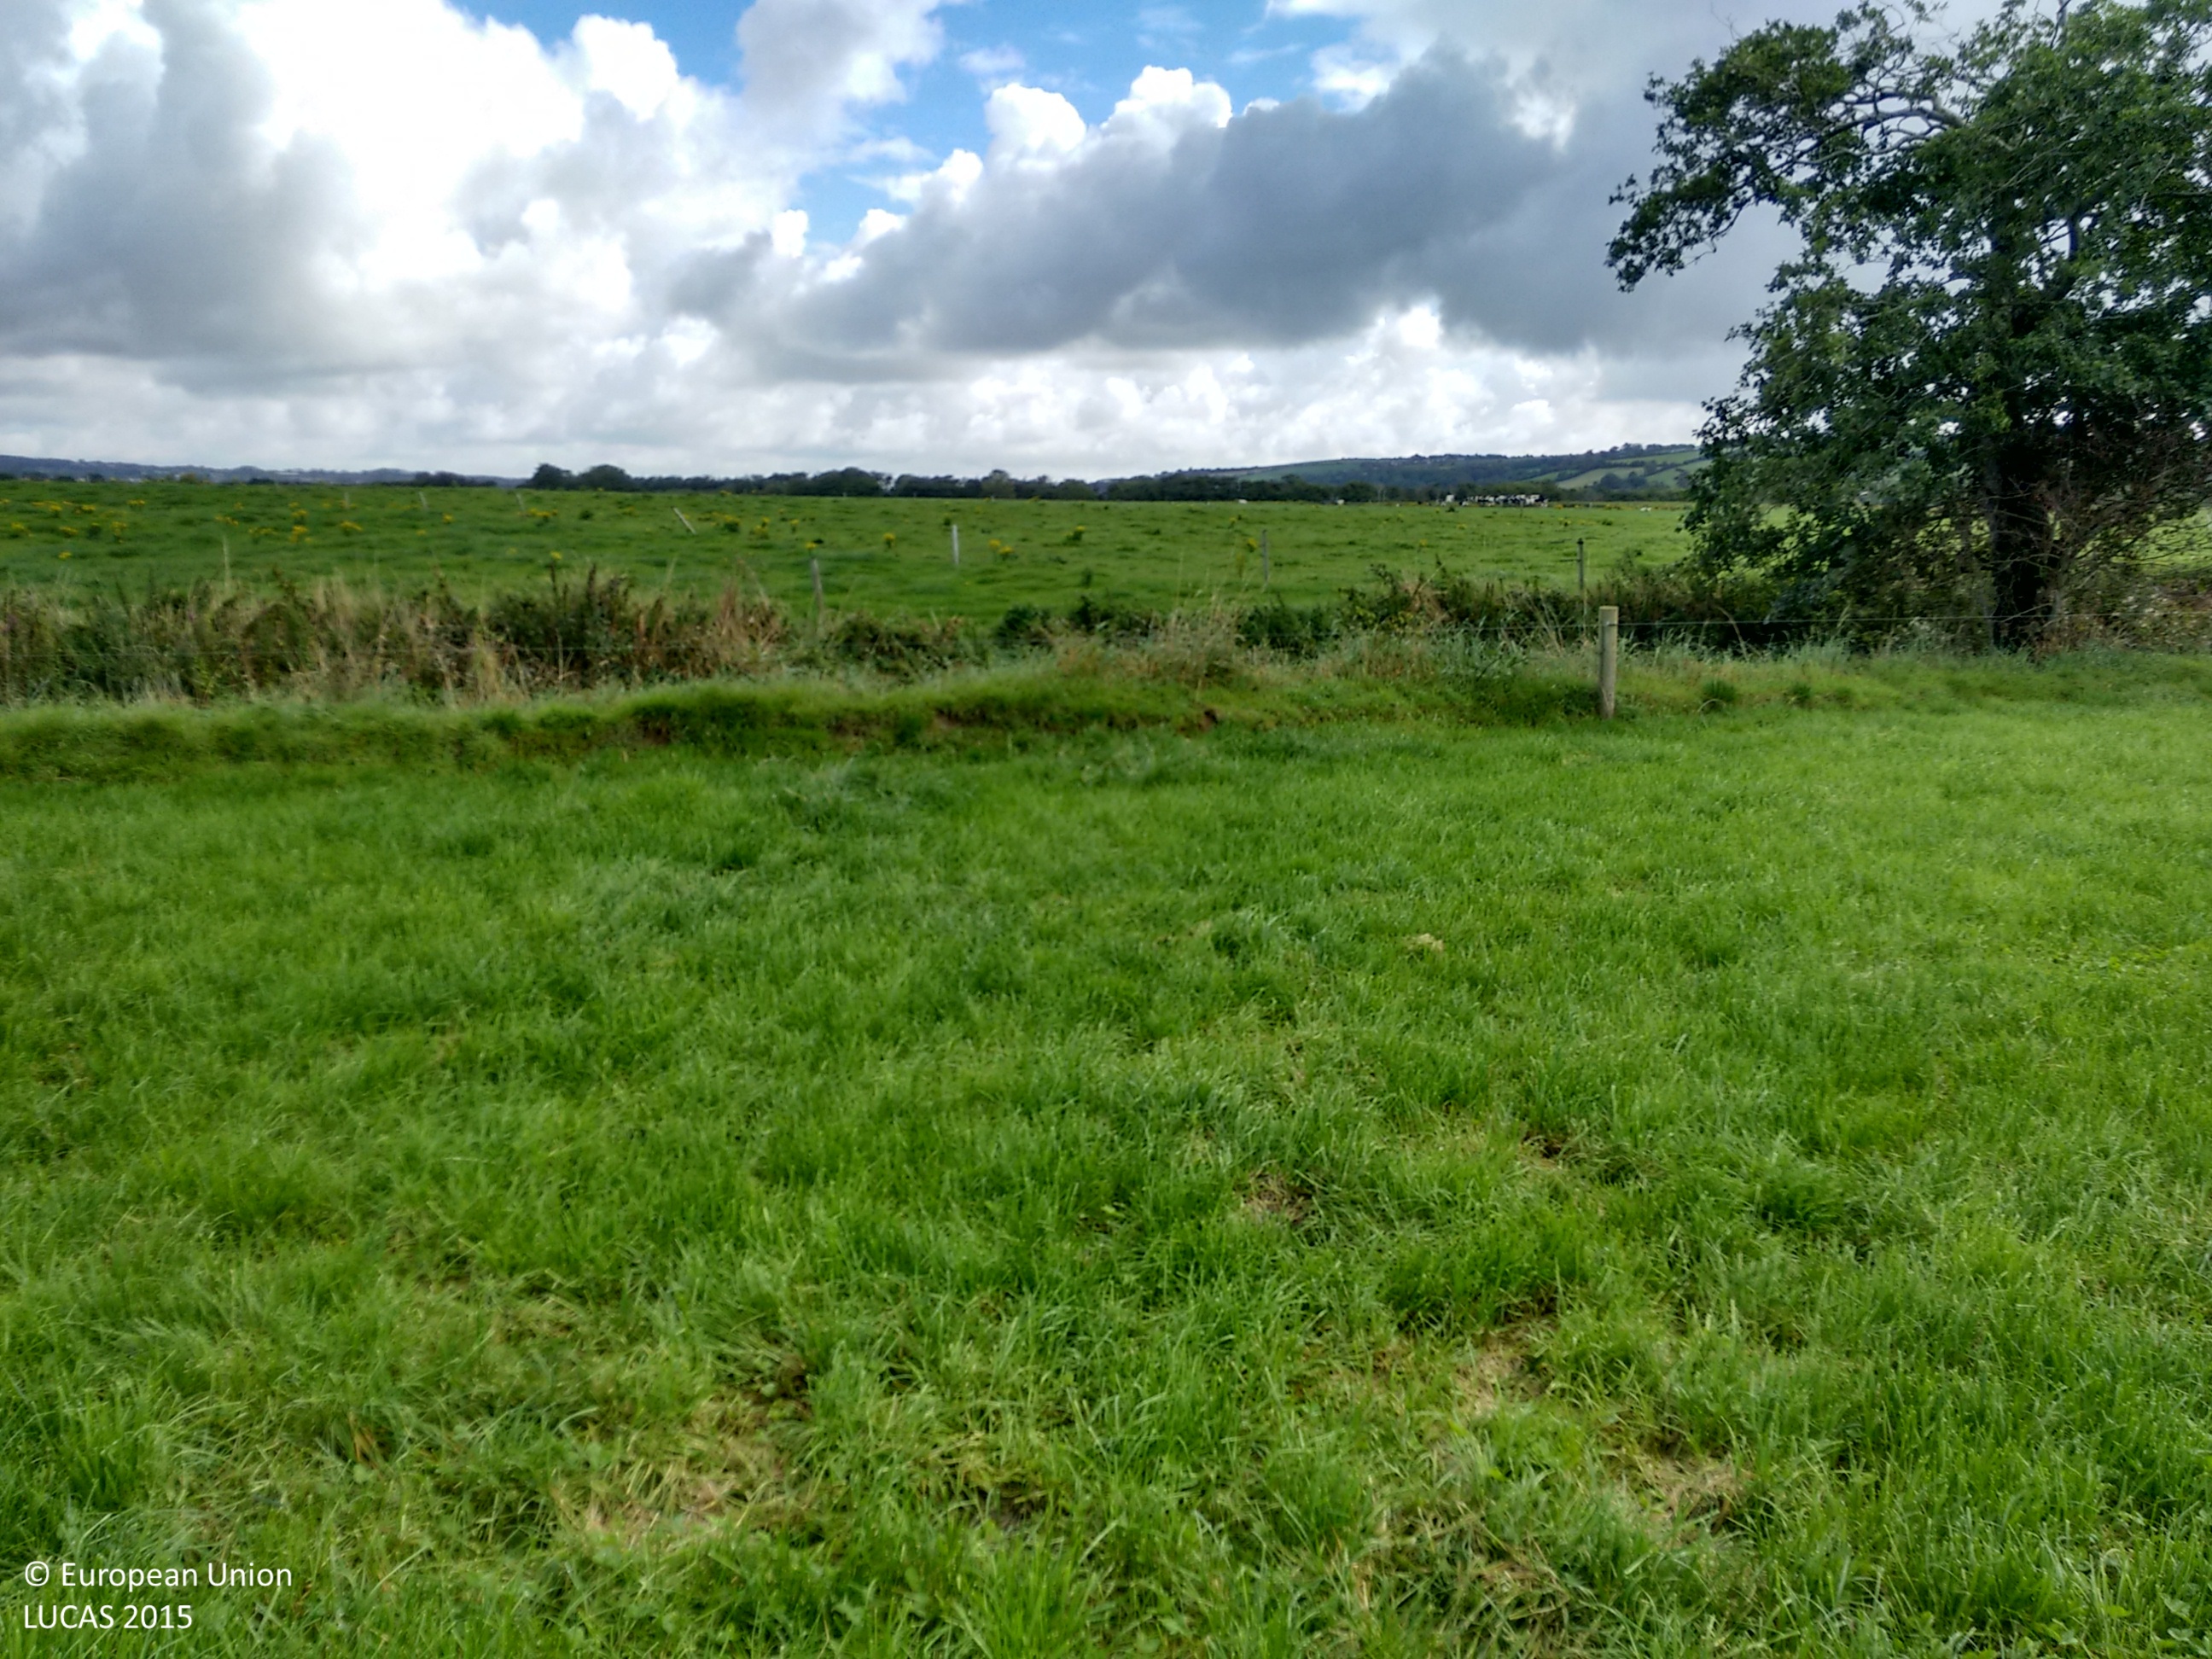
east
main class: Grassland
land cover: Grassland without tree/shrub cover
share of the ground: > 75 %
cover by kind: herbaceous plants 100 %
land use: Agriculture (excluding fallow land and kitchen gardens)
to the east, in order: Grassland without tree/shrub cover; Fences; Shruby margins; Ditches and canals; Fences; Grassland without tree/shrub cover; Fences; Grassland without tree/shrub cover
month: September
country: IE
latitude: 52.4383
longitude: -9.5189
